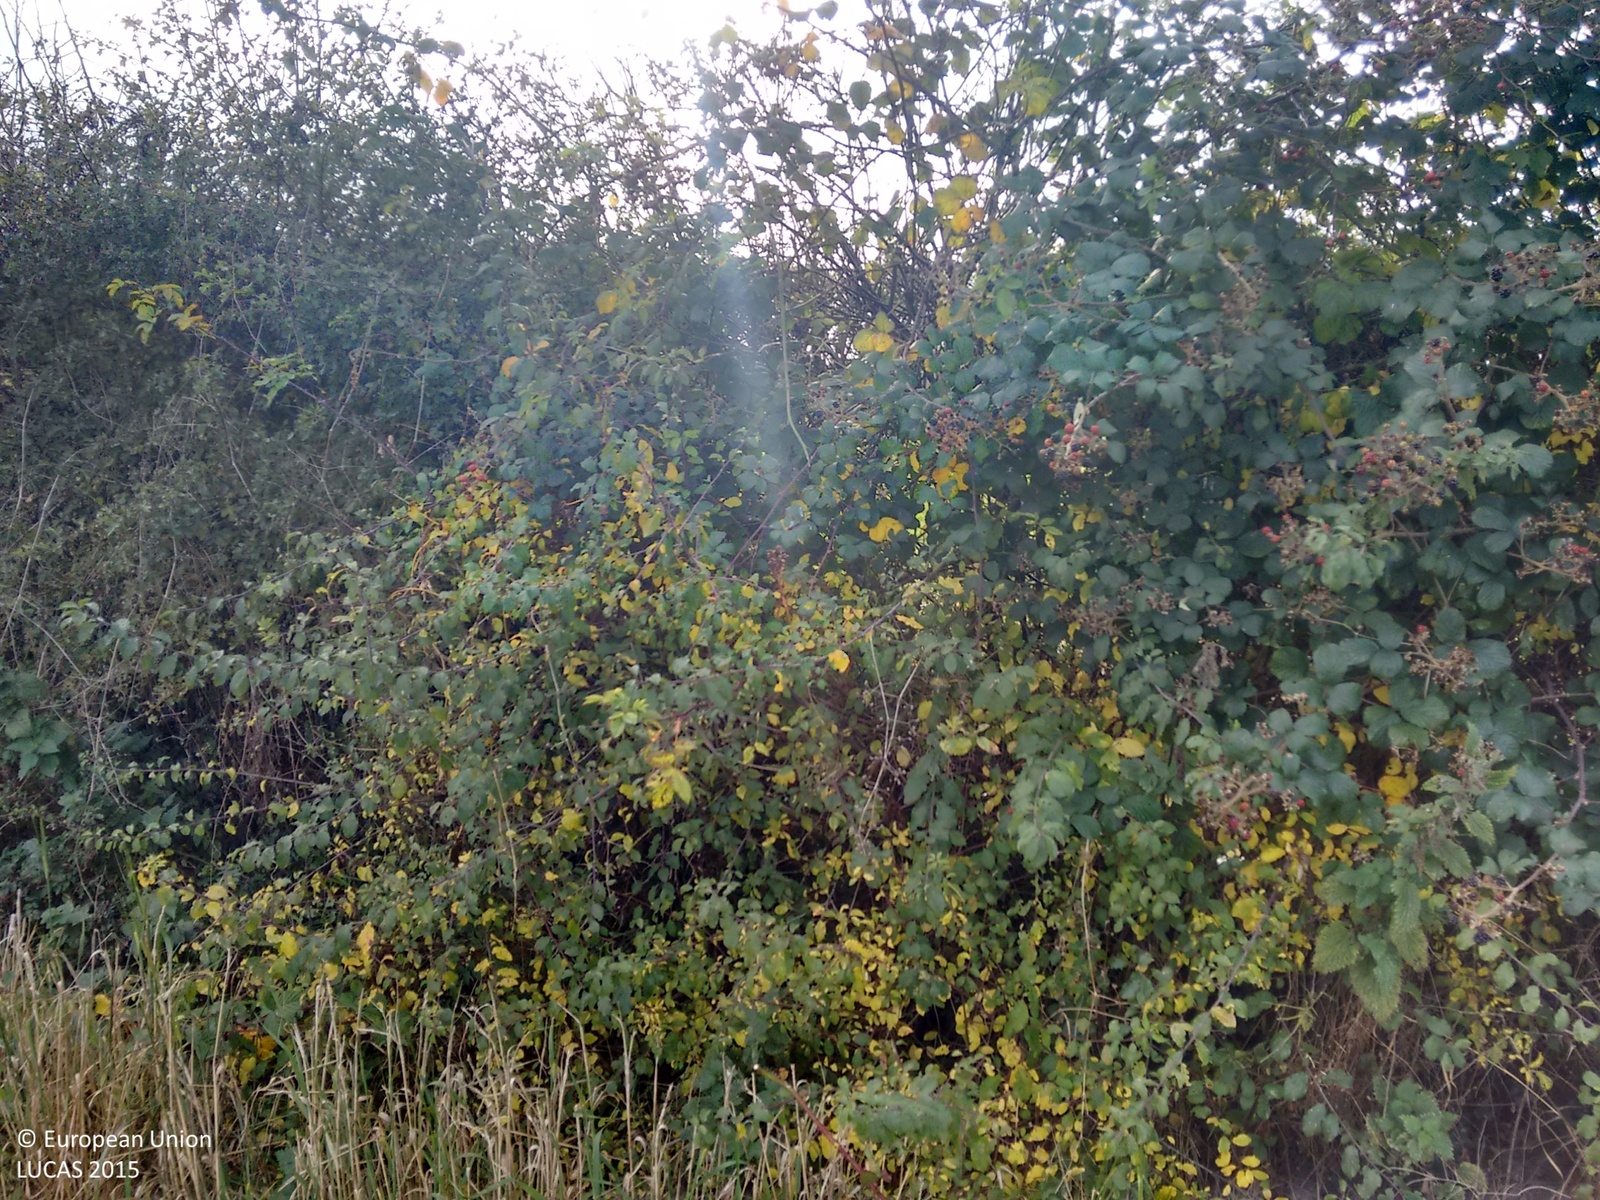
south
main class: Grassland
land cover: Grassland without tree/shrub cover
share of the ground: > 75 %
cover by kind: herbaceous plants 85 %, shrubs 5 %
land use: Agriculture (excluding fallow land and kitchen gardens)
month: October
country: IE
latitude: 53.1467
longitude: -7.7342
